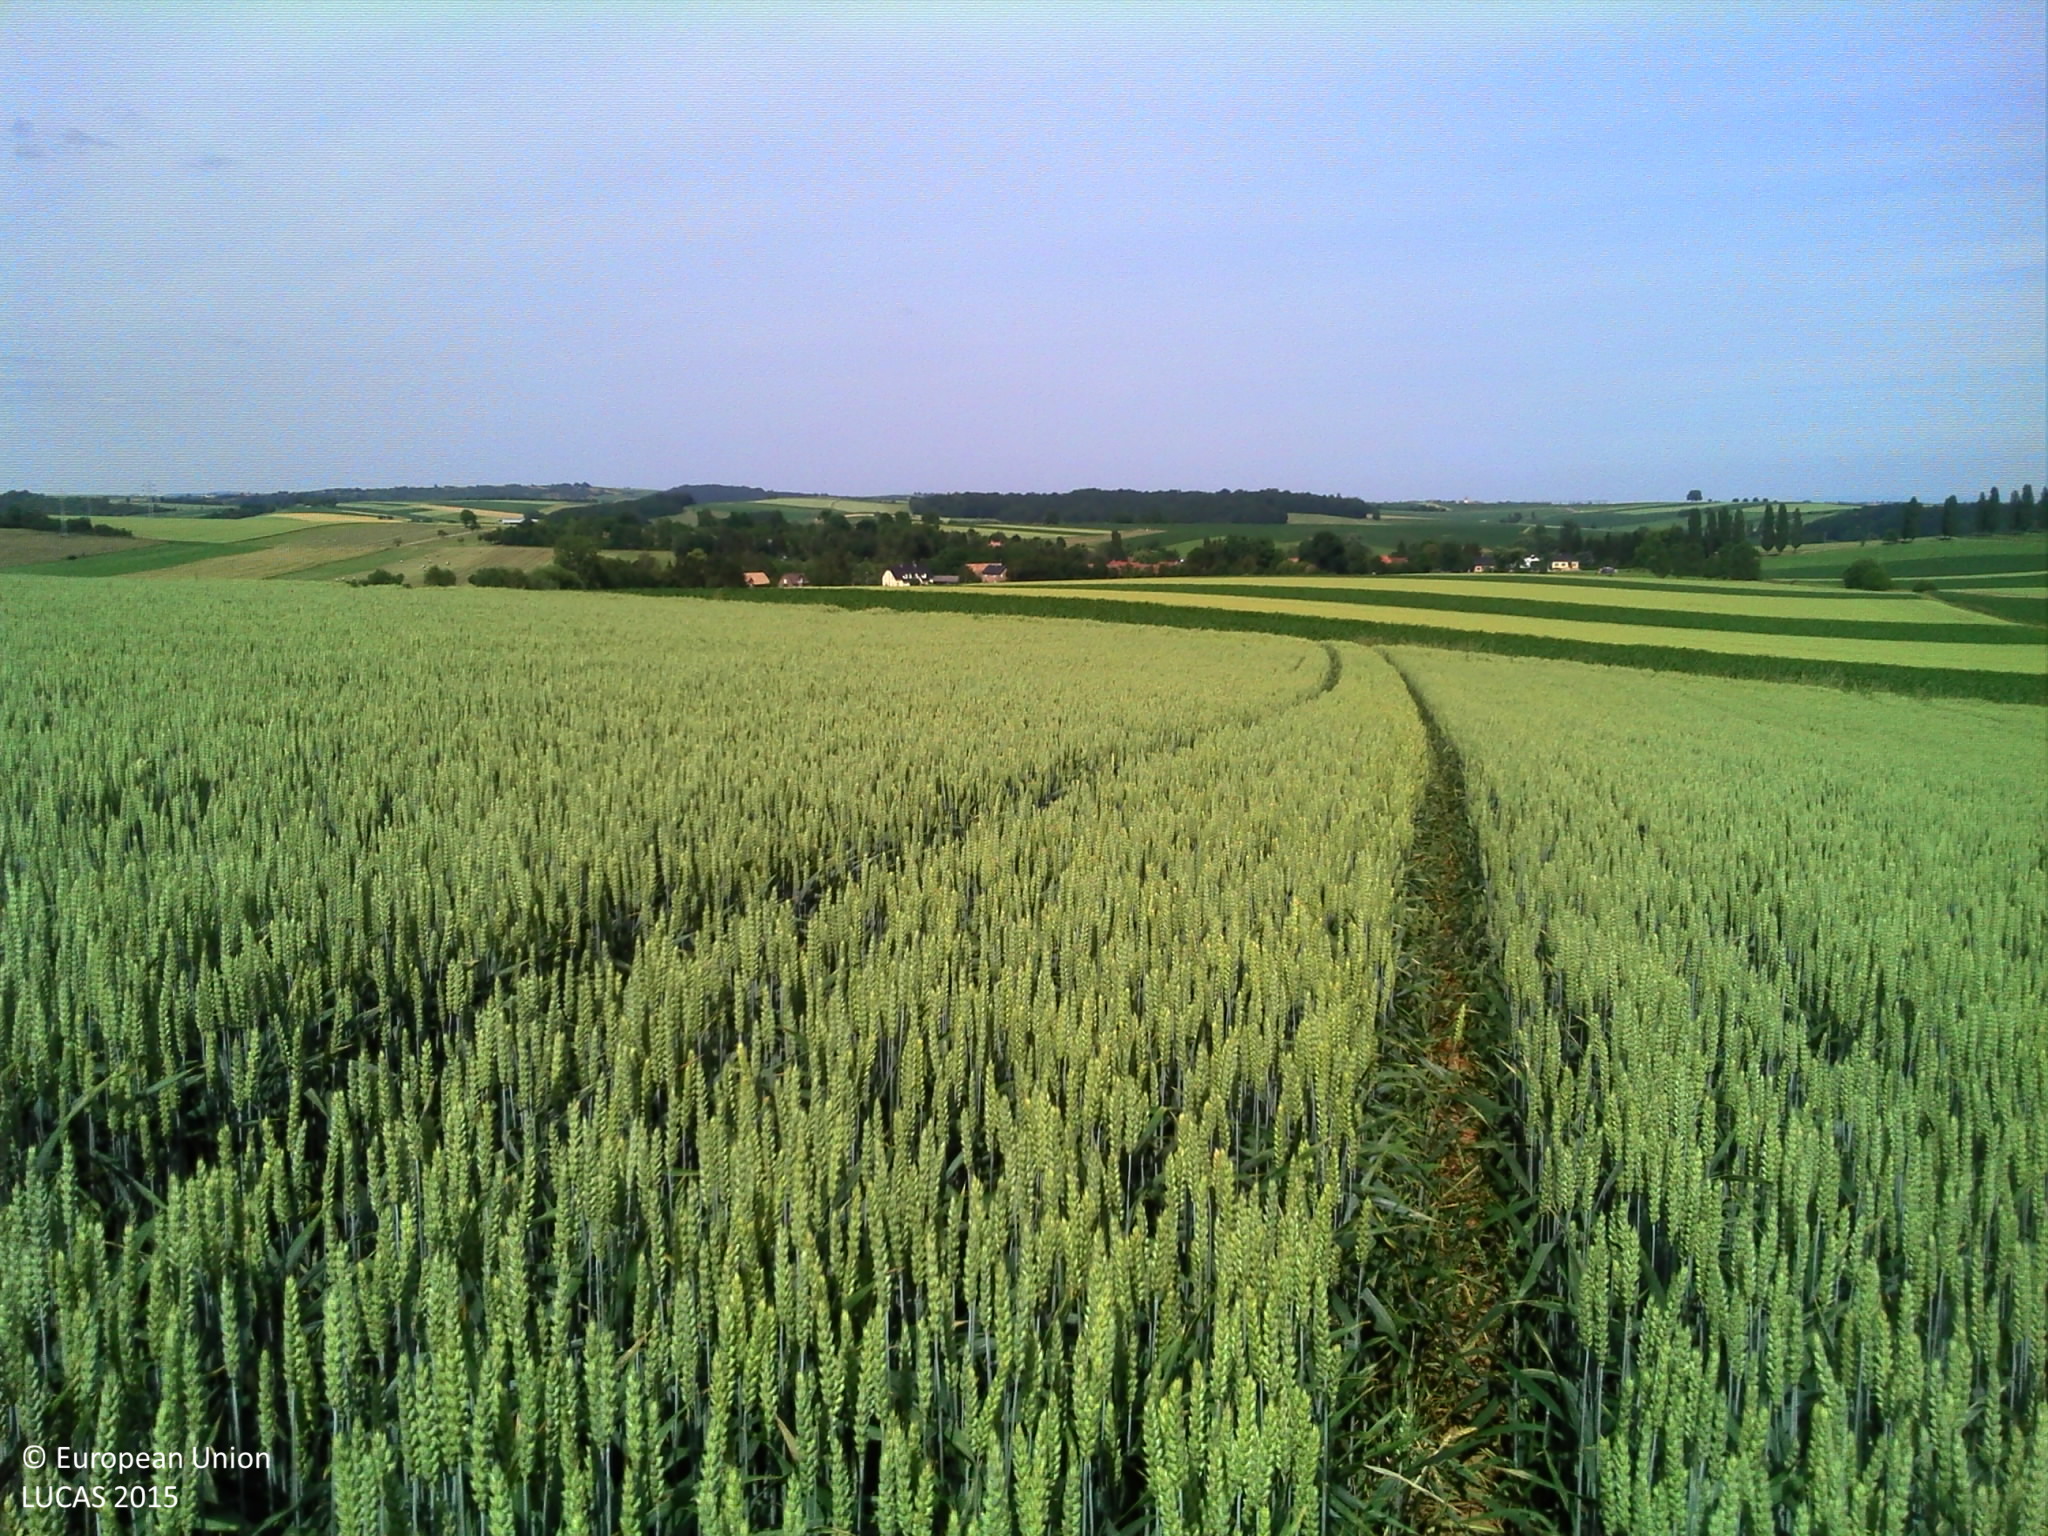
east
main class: Cropland
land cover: Common wheat
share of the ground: > 75 %
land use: Agriculture (excluding fallow land and kitchen gardens)
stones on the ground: < 10 %
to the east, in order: Common wheat; Tracks; Maize; Common wheat; Maize
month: June
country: FR
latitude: 48.7721
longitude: 7.5379
